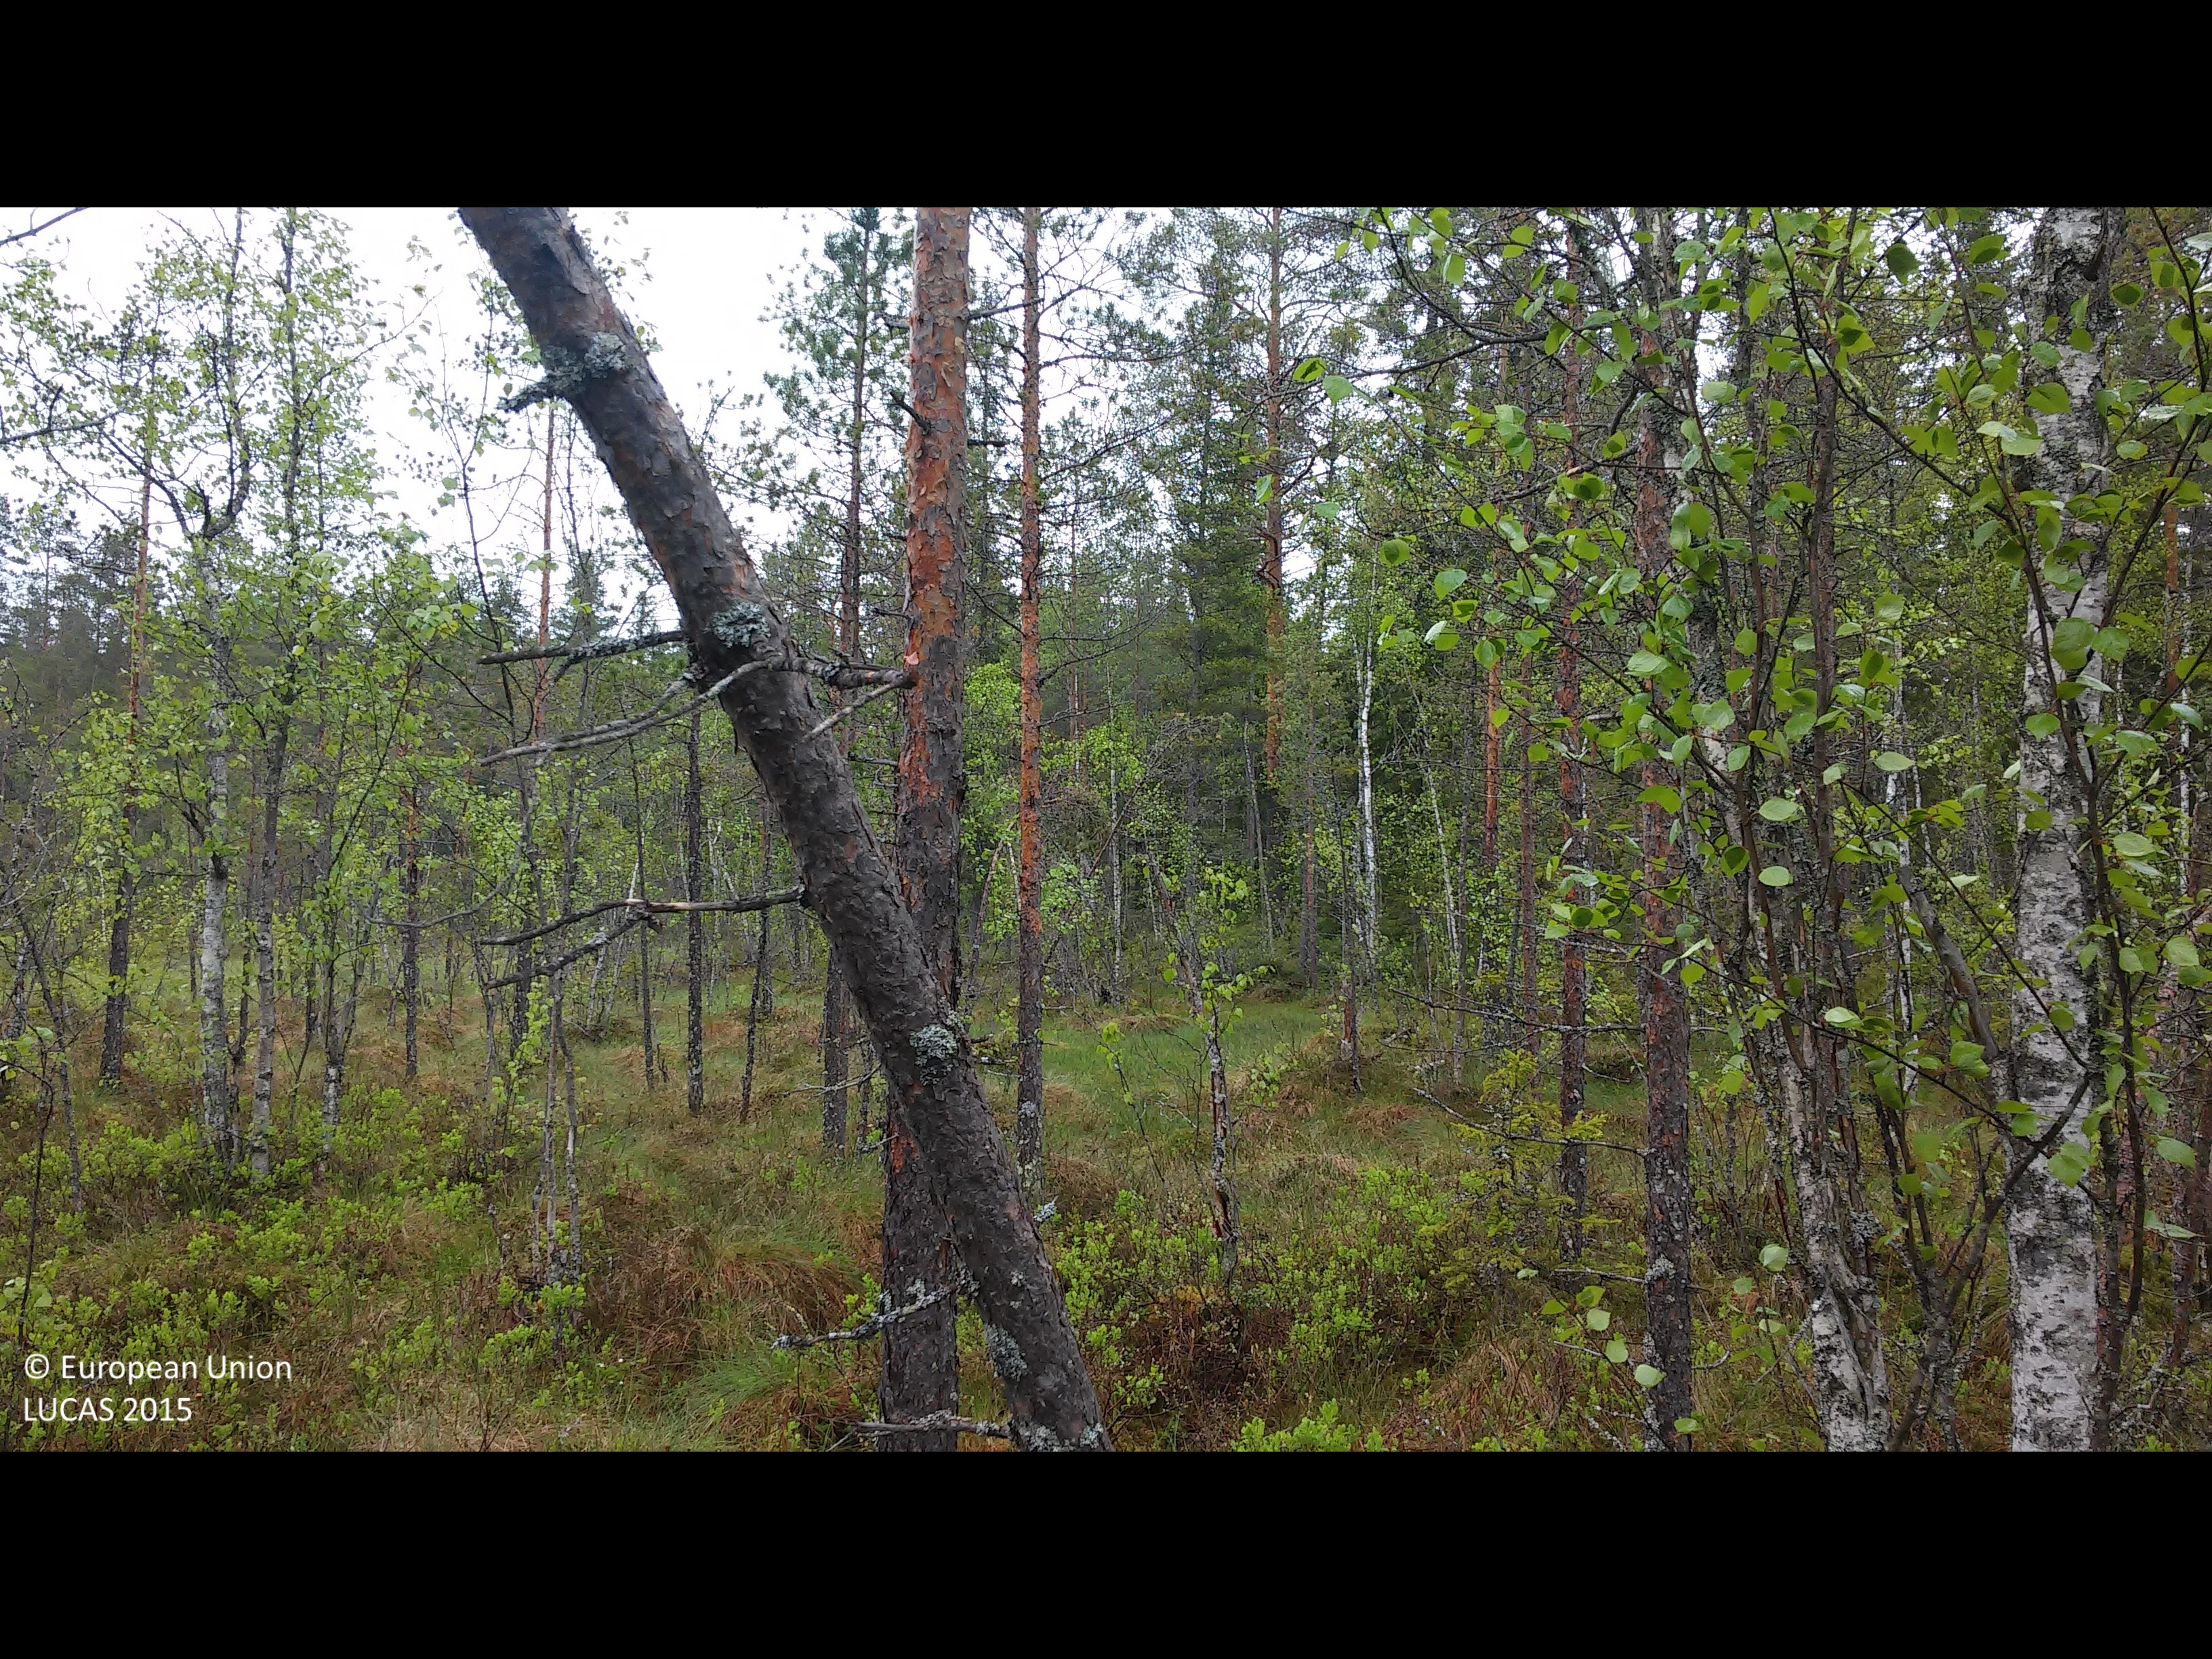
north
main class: Woodland
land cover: Pine dominated mixed woodland
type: boreal forest
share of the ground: > 75 %
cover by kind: coniferous forest trees 55 %, broadleaved forest trees 20 %, shrubs 15 %, lichens and mosses 10 %
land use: Semi-natural and natural areas not in use
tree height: > 5 m
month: June
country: FI
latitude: 63.7030
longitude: 23.9669
